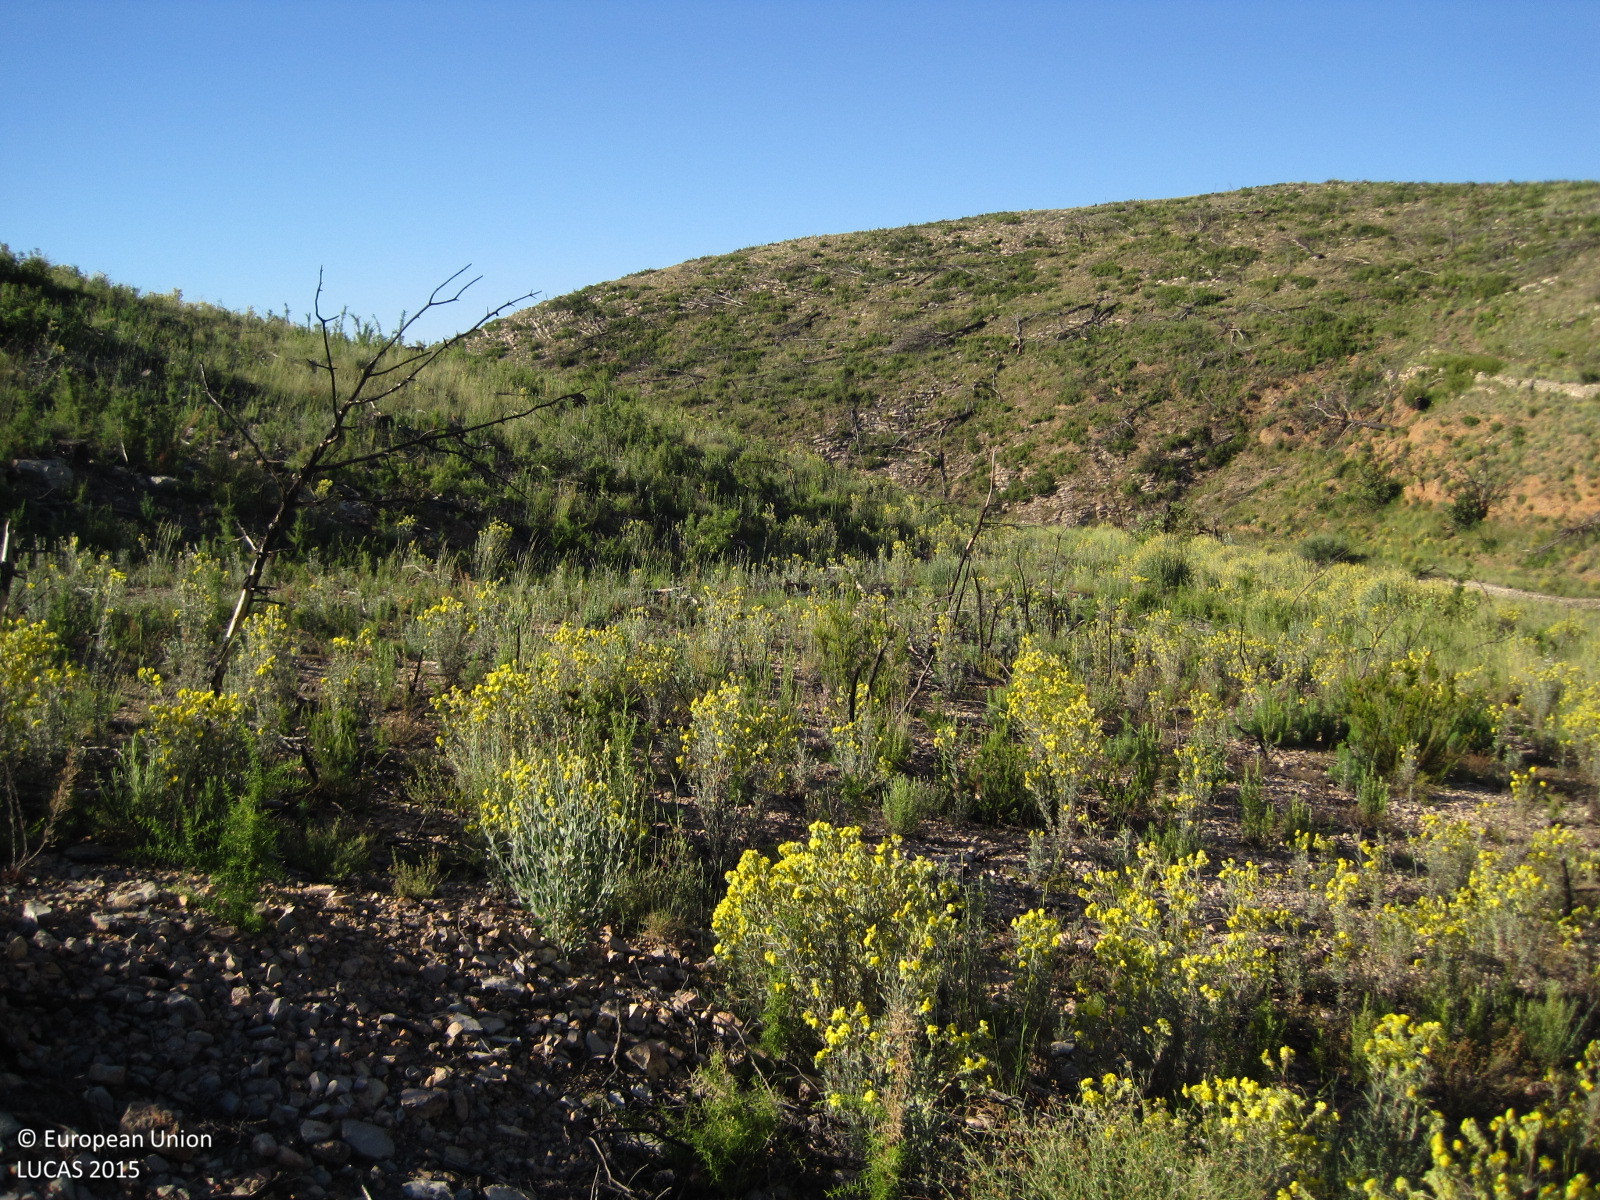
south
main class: Shrubland
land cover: Shrubland without tree cover
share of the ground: 25 - 50 %
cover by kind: shrubs 75 %, herbaceous plants 15 %, consolidated bare surface 5 %, unconsolidated bare surface 5 %
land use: Semi-natural and natural areas not in use
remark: Burnt area
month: May
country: ES
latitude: 39.7554
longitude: -0.6814
